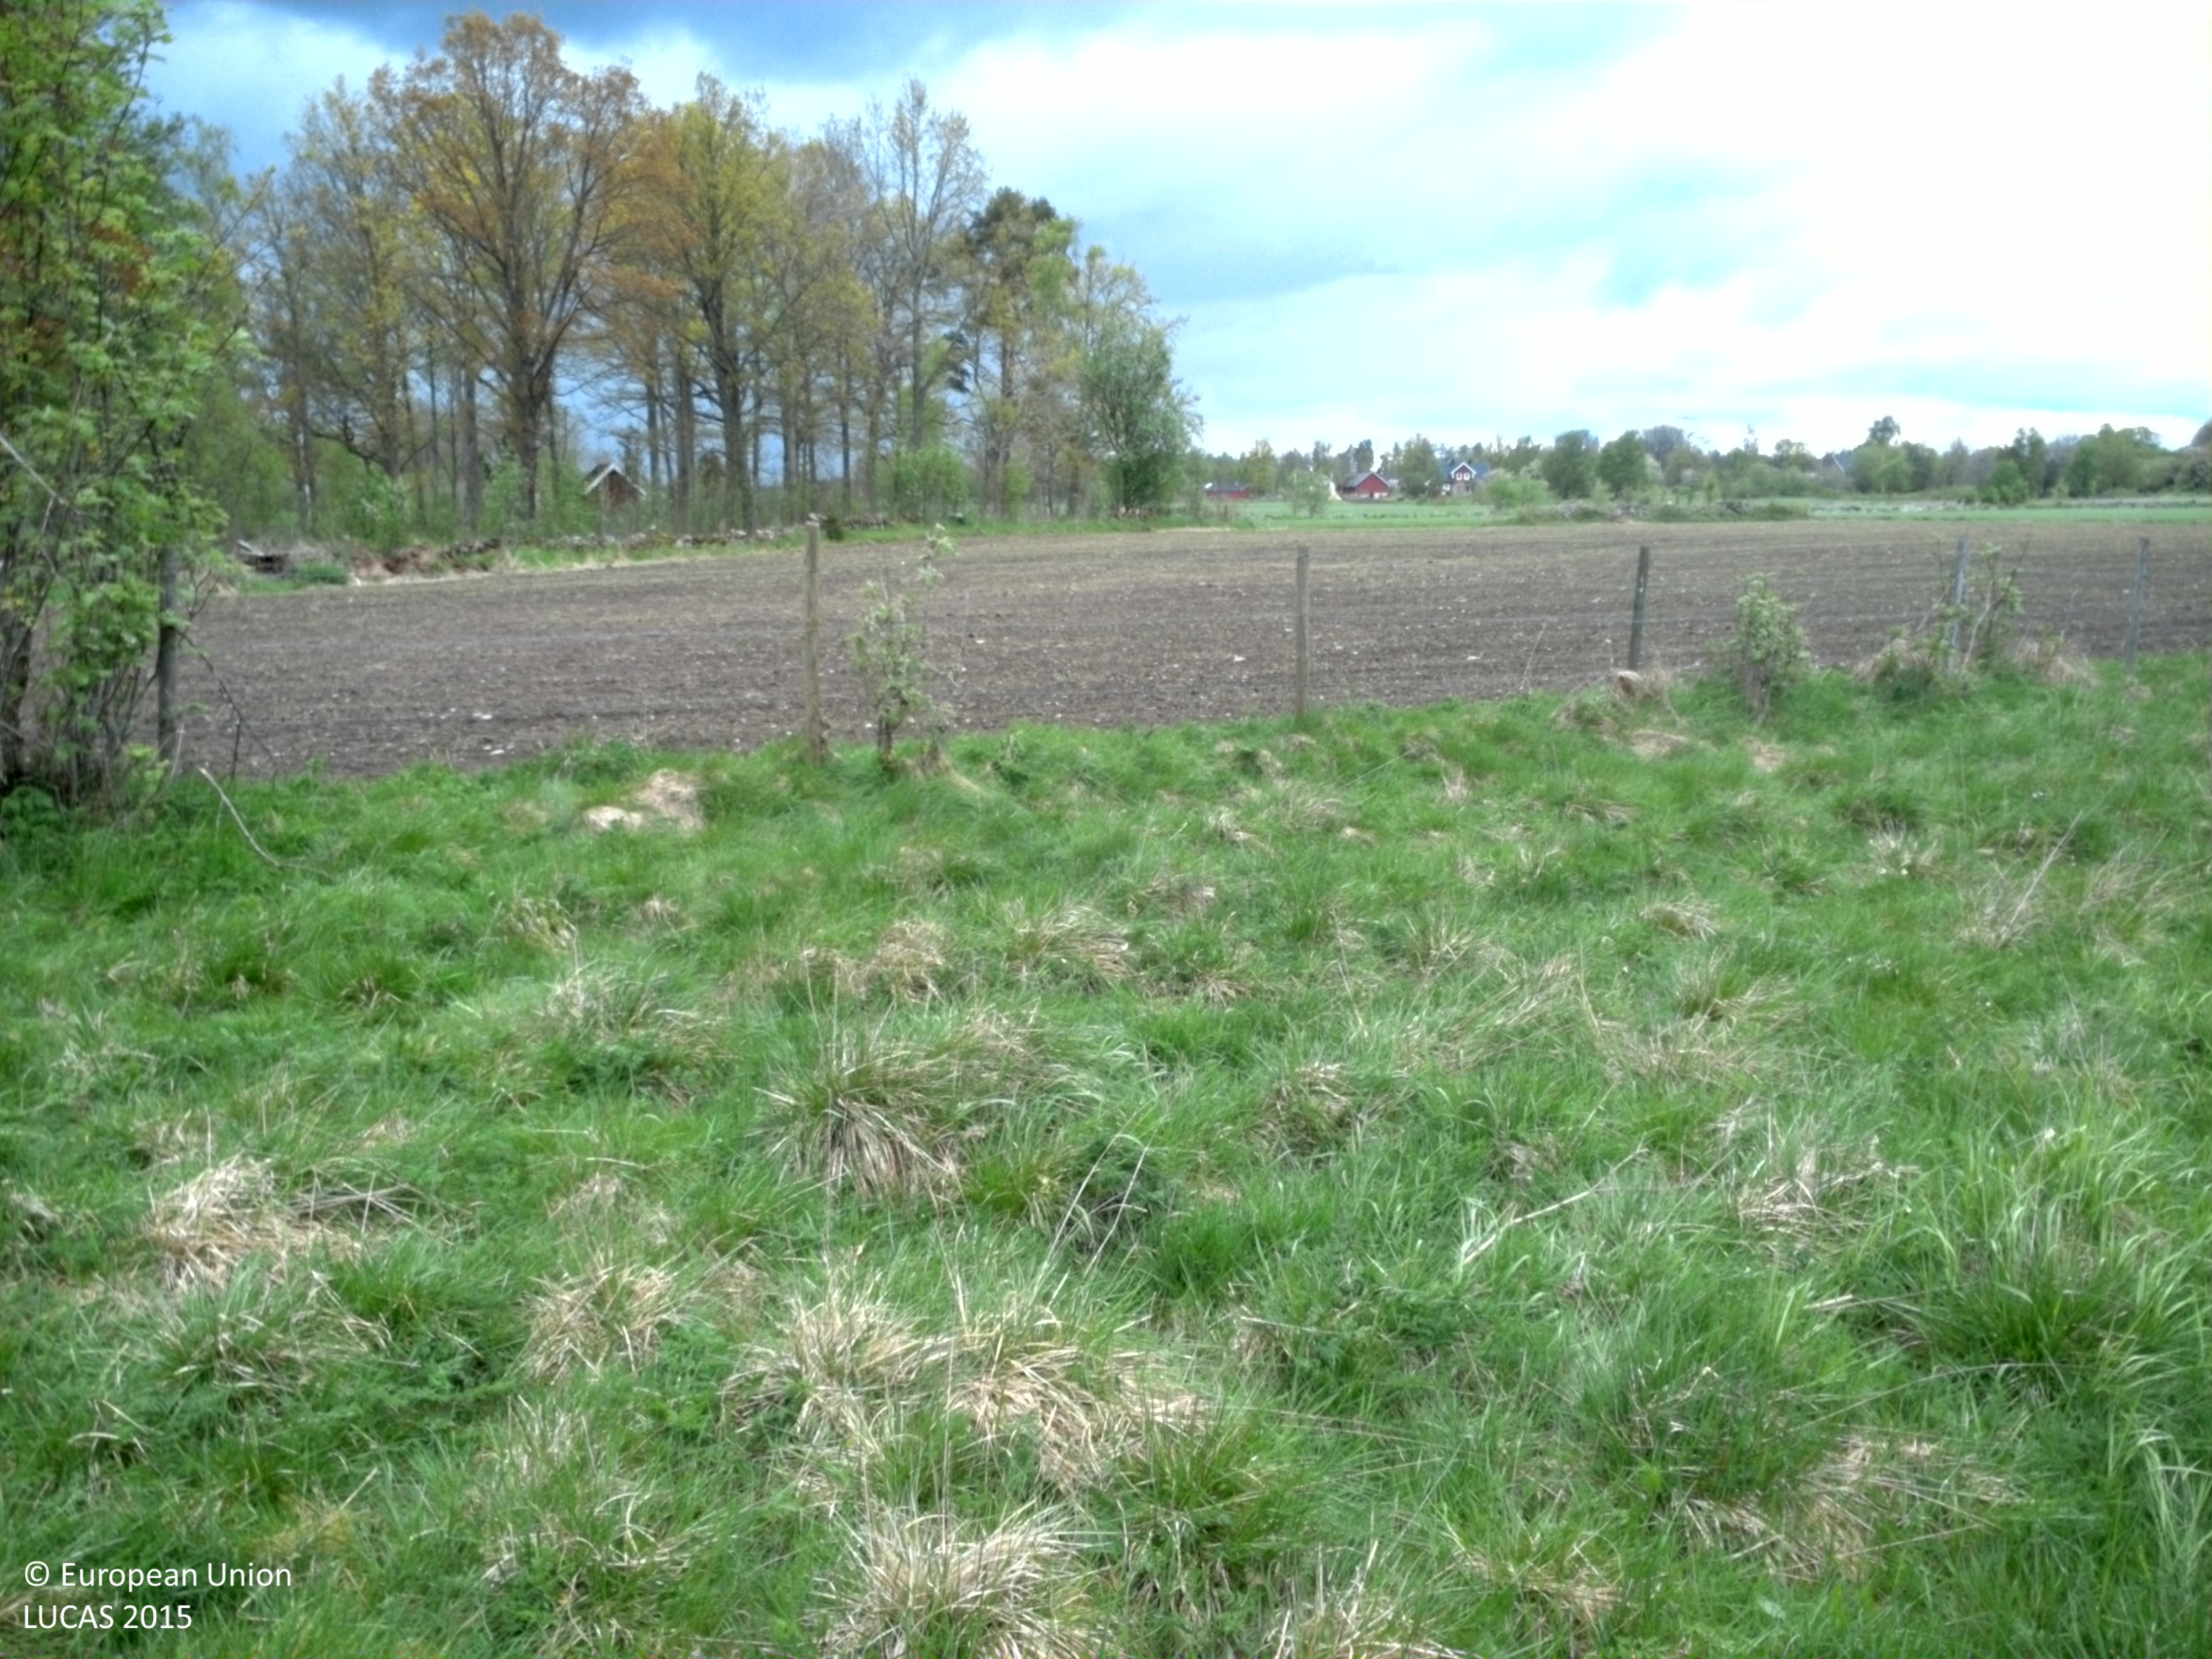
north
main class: Grassland
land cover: Grassland with sparse tree/shrub cover
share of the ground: > 75 %
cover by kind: herbaceous plants 90 %, coniferous forest trees 5 %, lichens and mosses 5 %
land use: Agriculture (excluding fallow land and kitchen gardens)
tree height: < 5 m
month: May
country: SE
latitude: 56.7135
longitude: 14.7188
